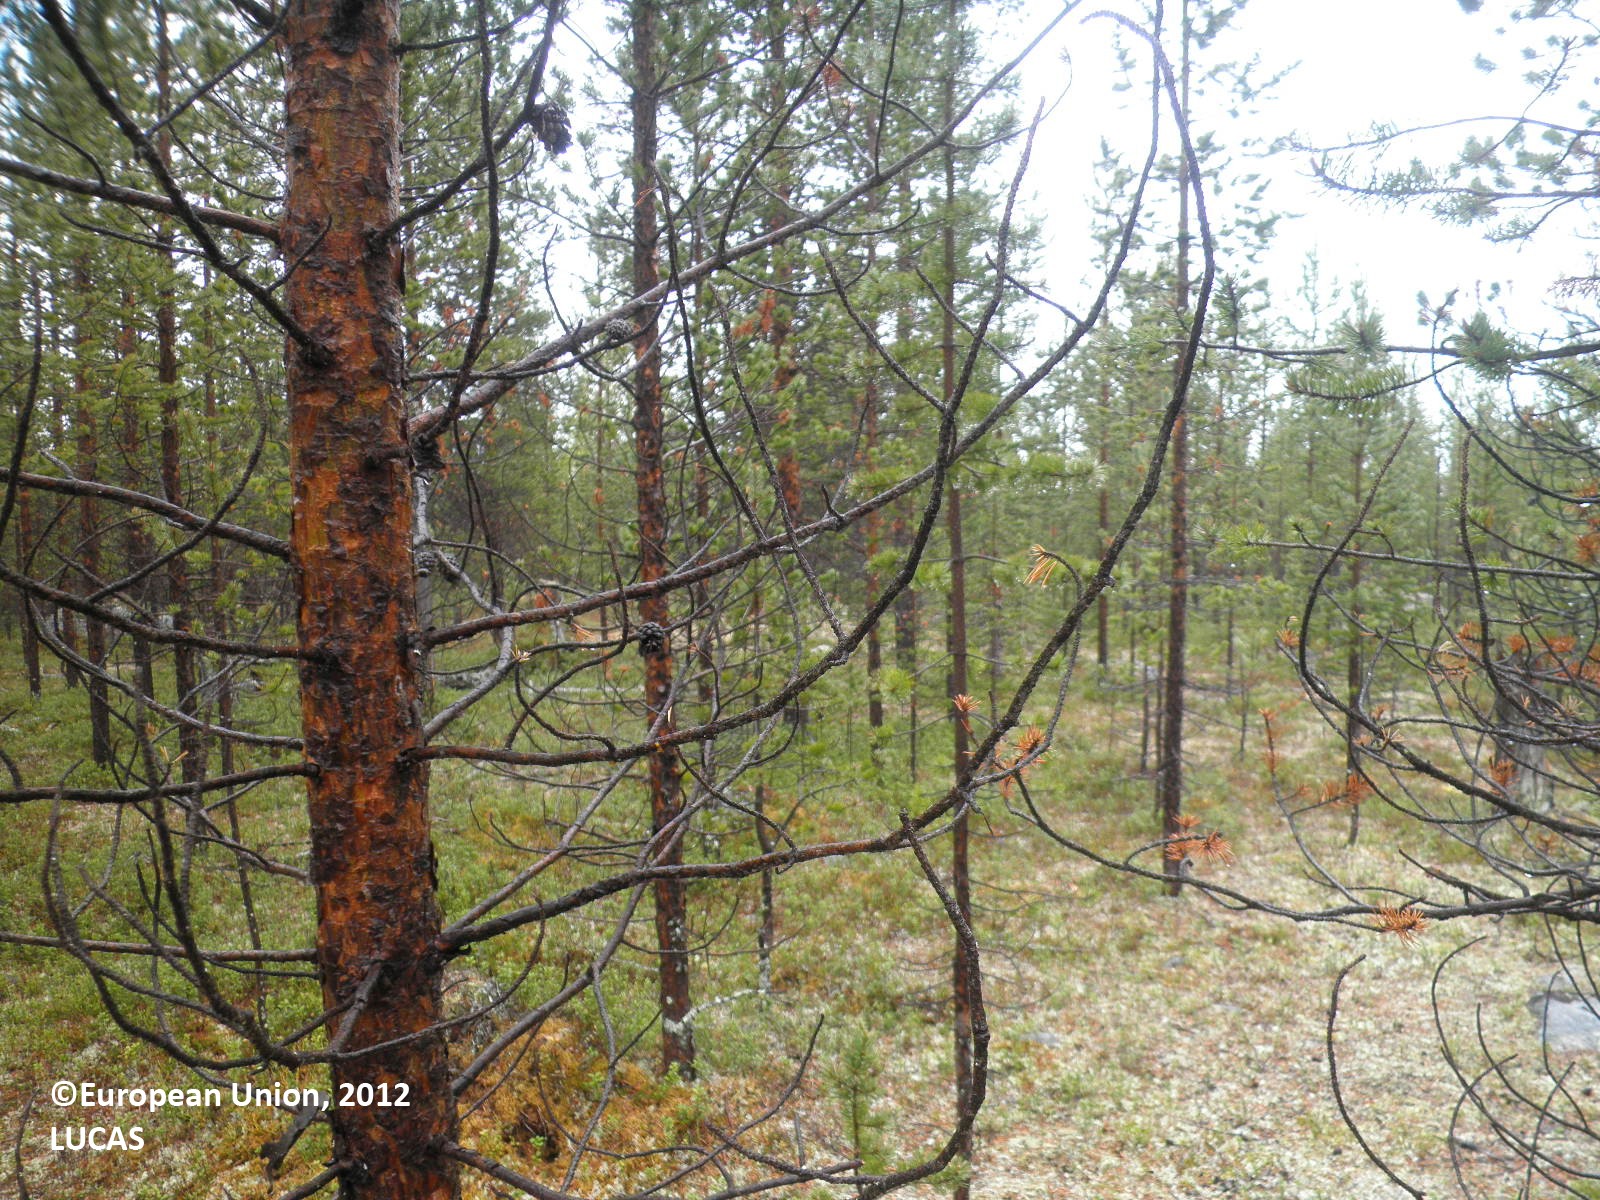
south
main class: Woodland
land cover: Pine dominated coniferous woodland
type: boreal forest
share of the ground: 50 - 75 %
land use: Forestry
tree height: > 5 m
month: June
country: FI
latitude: 68.8978
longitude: 26.7534
